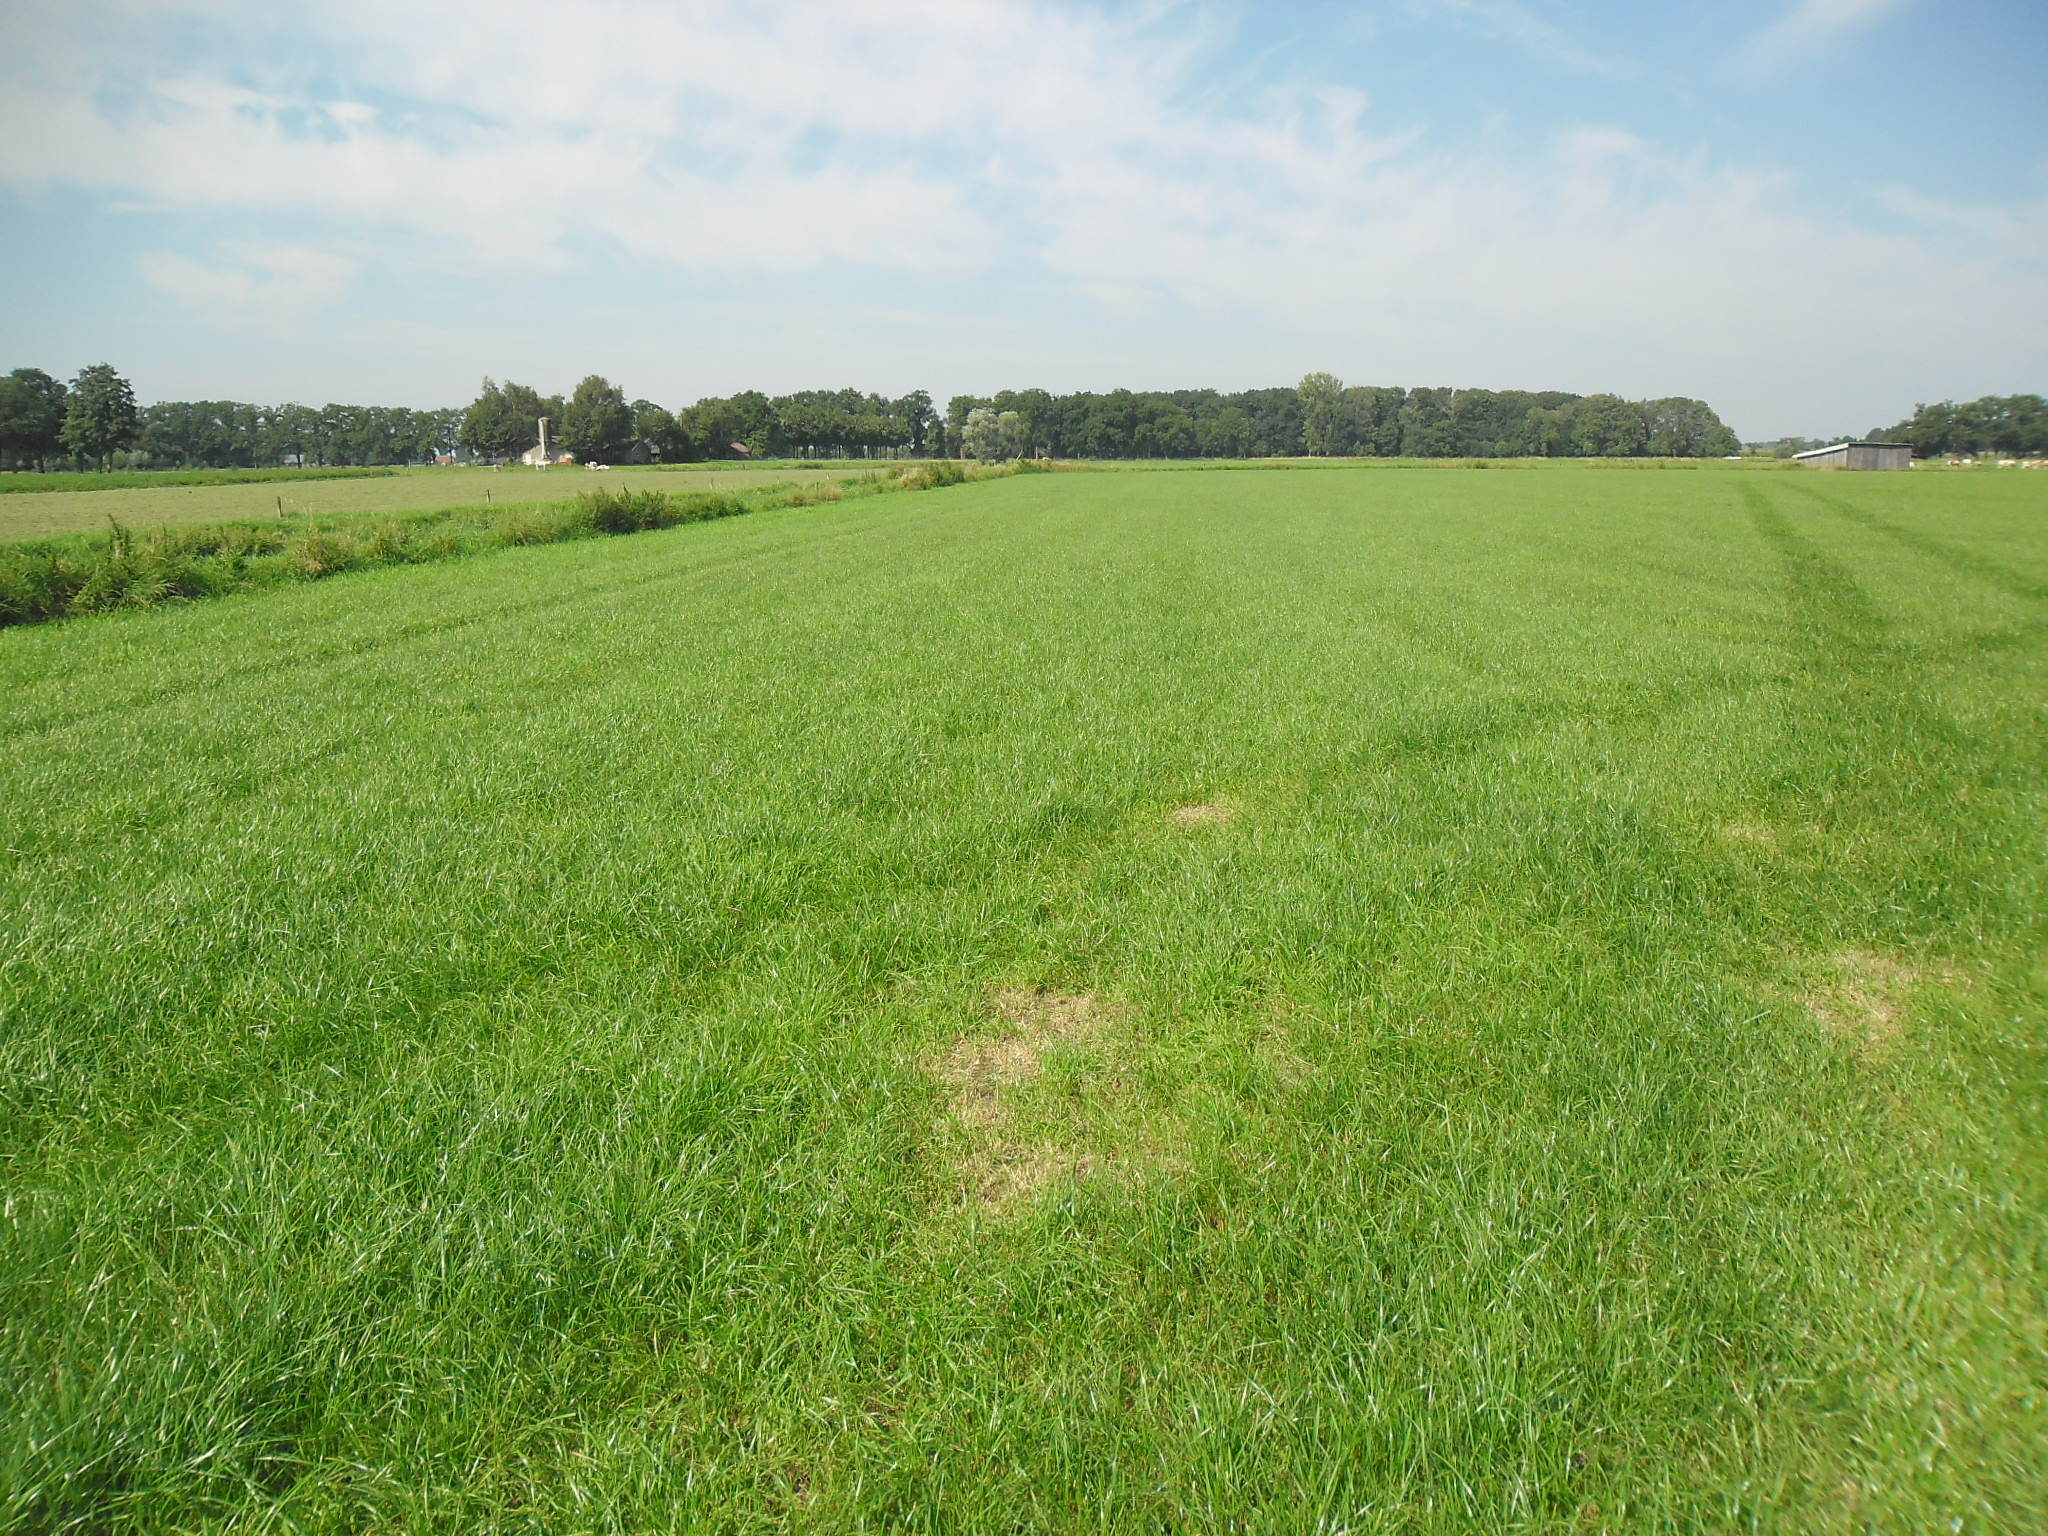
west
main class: Grassland
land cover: Grassland without tree/shrub cover
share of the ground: > 75 %
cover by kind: herbaceous plants 100 %
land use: Agriculture (excluding fallow land and kitchen gardens)
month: August
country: NL
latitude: 52.4064
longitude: 6.1923
